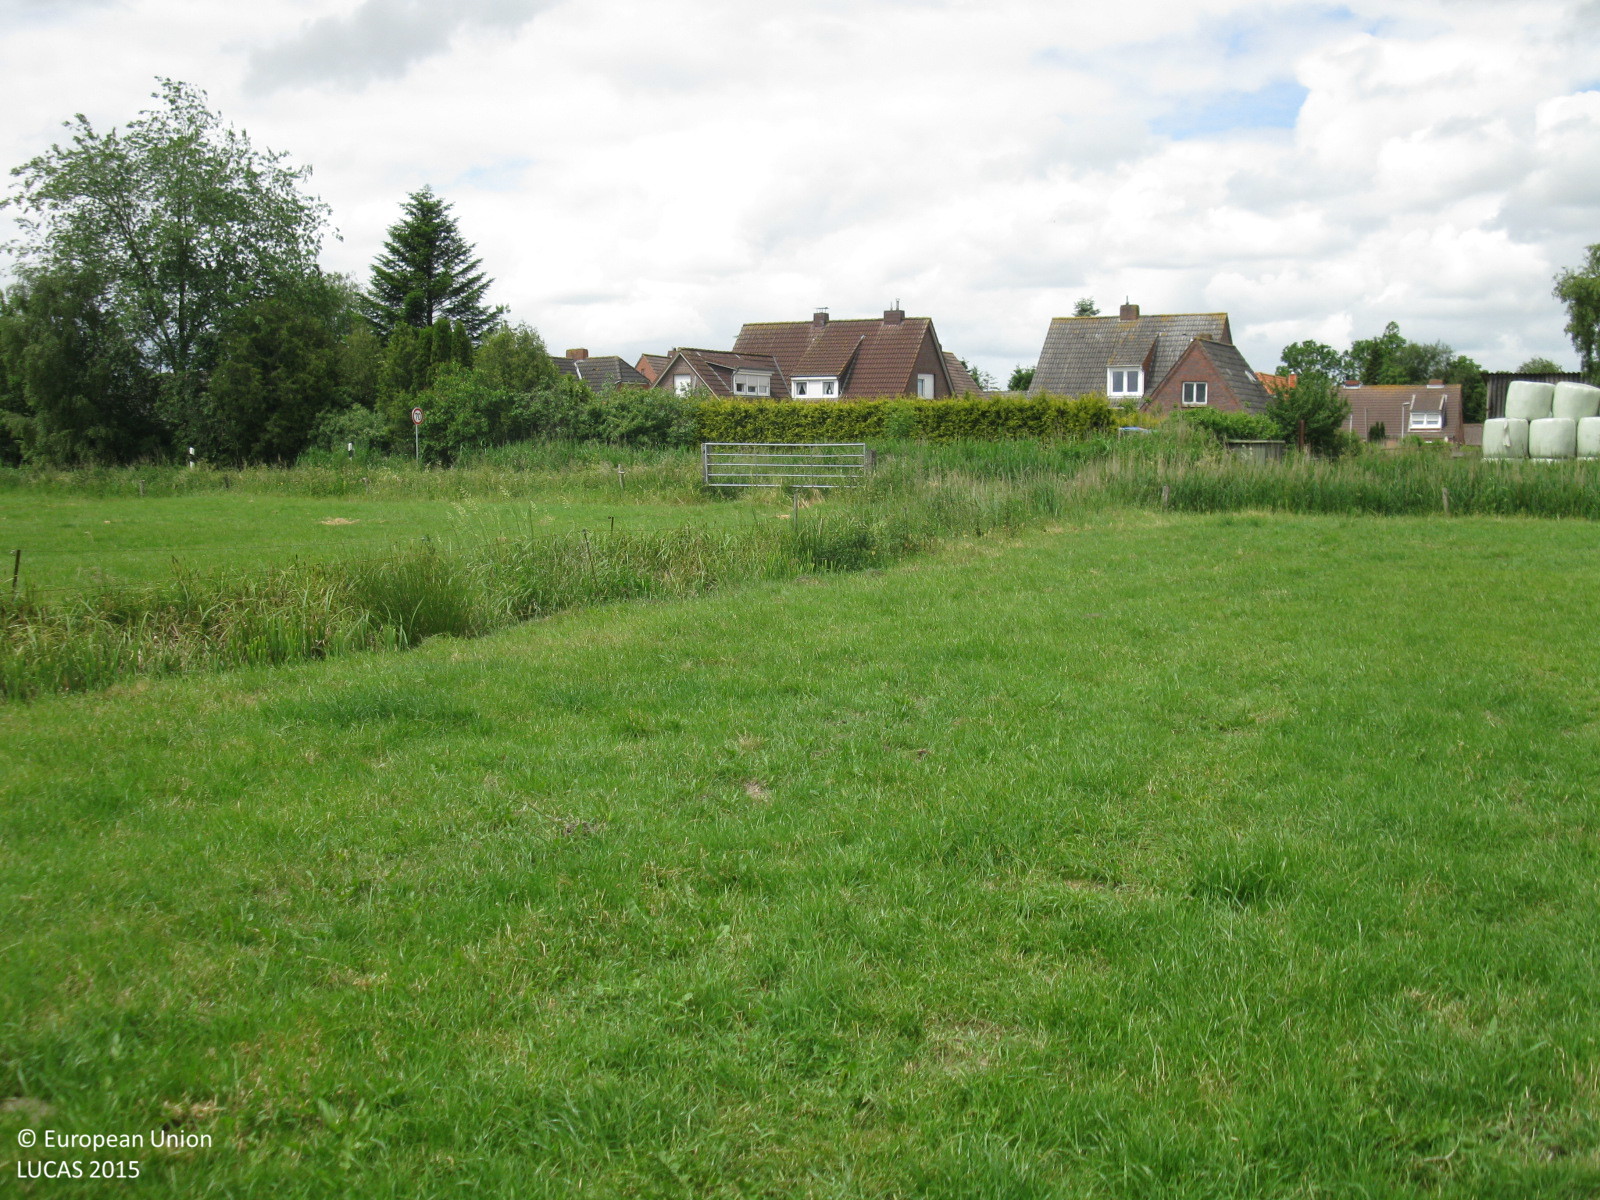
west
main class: Grassland
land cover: Grassland without tree/shrub cover
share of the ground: > 75 %
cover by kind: herbaceous plants 100 %
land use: Agriculture (excluding fallow land and kitchen gardens)
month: June
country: DE
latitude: 53.3368
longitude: 7.3424
